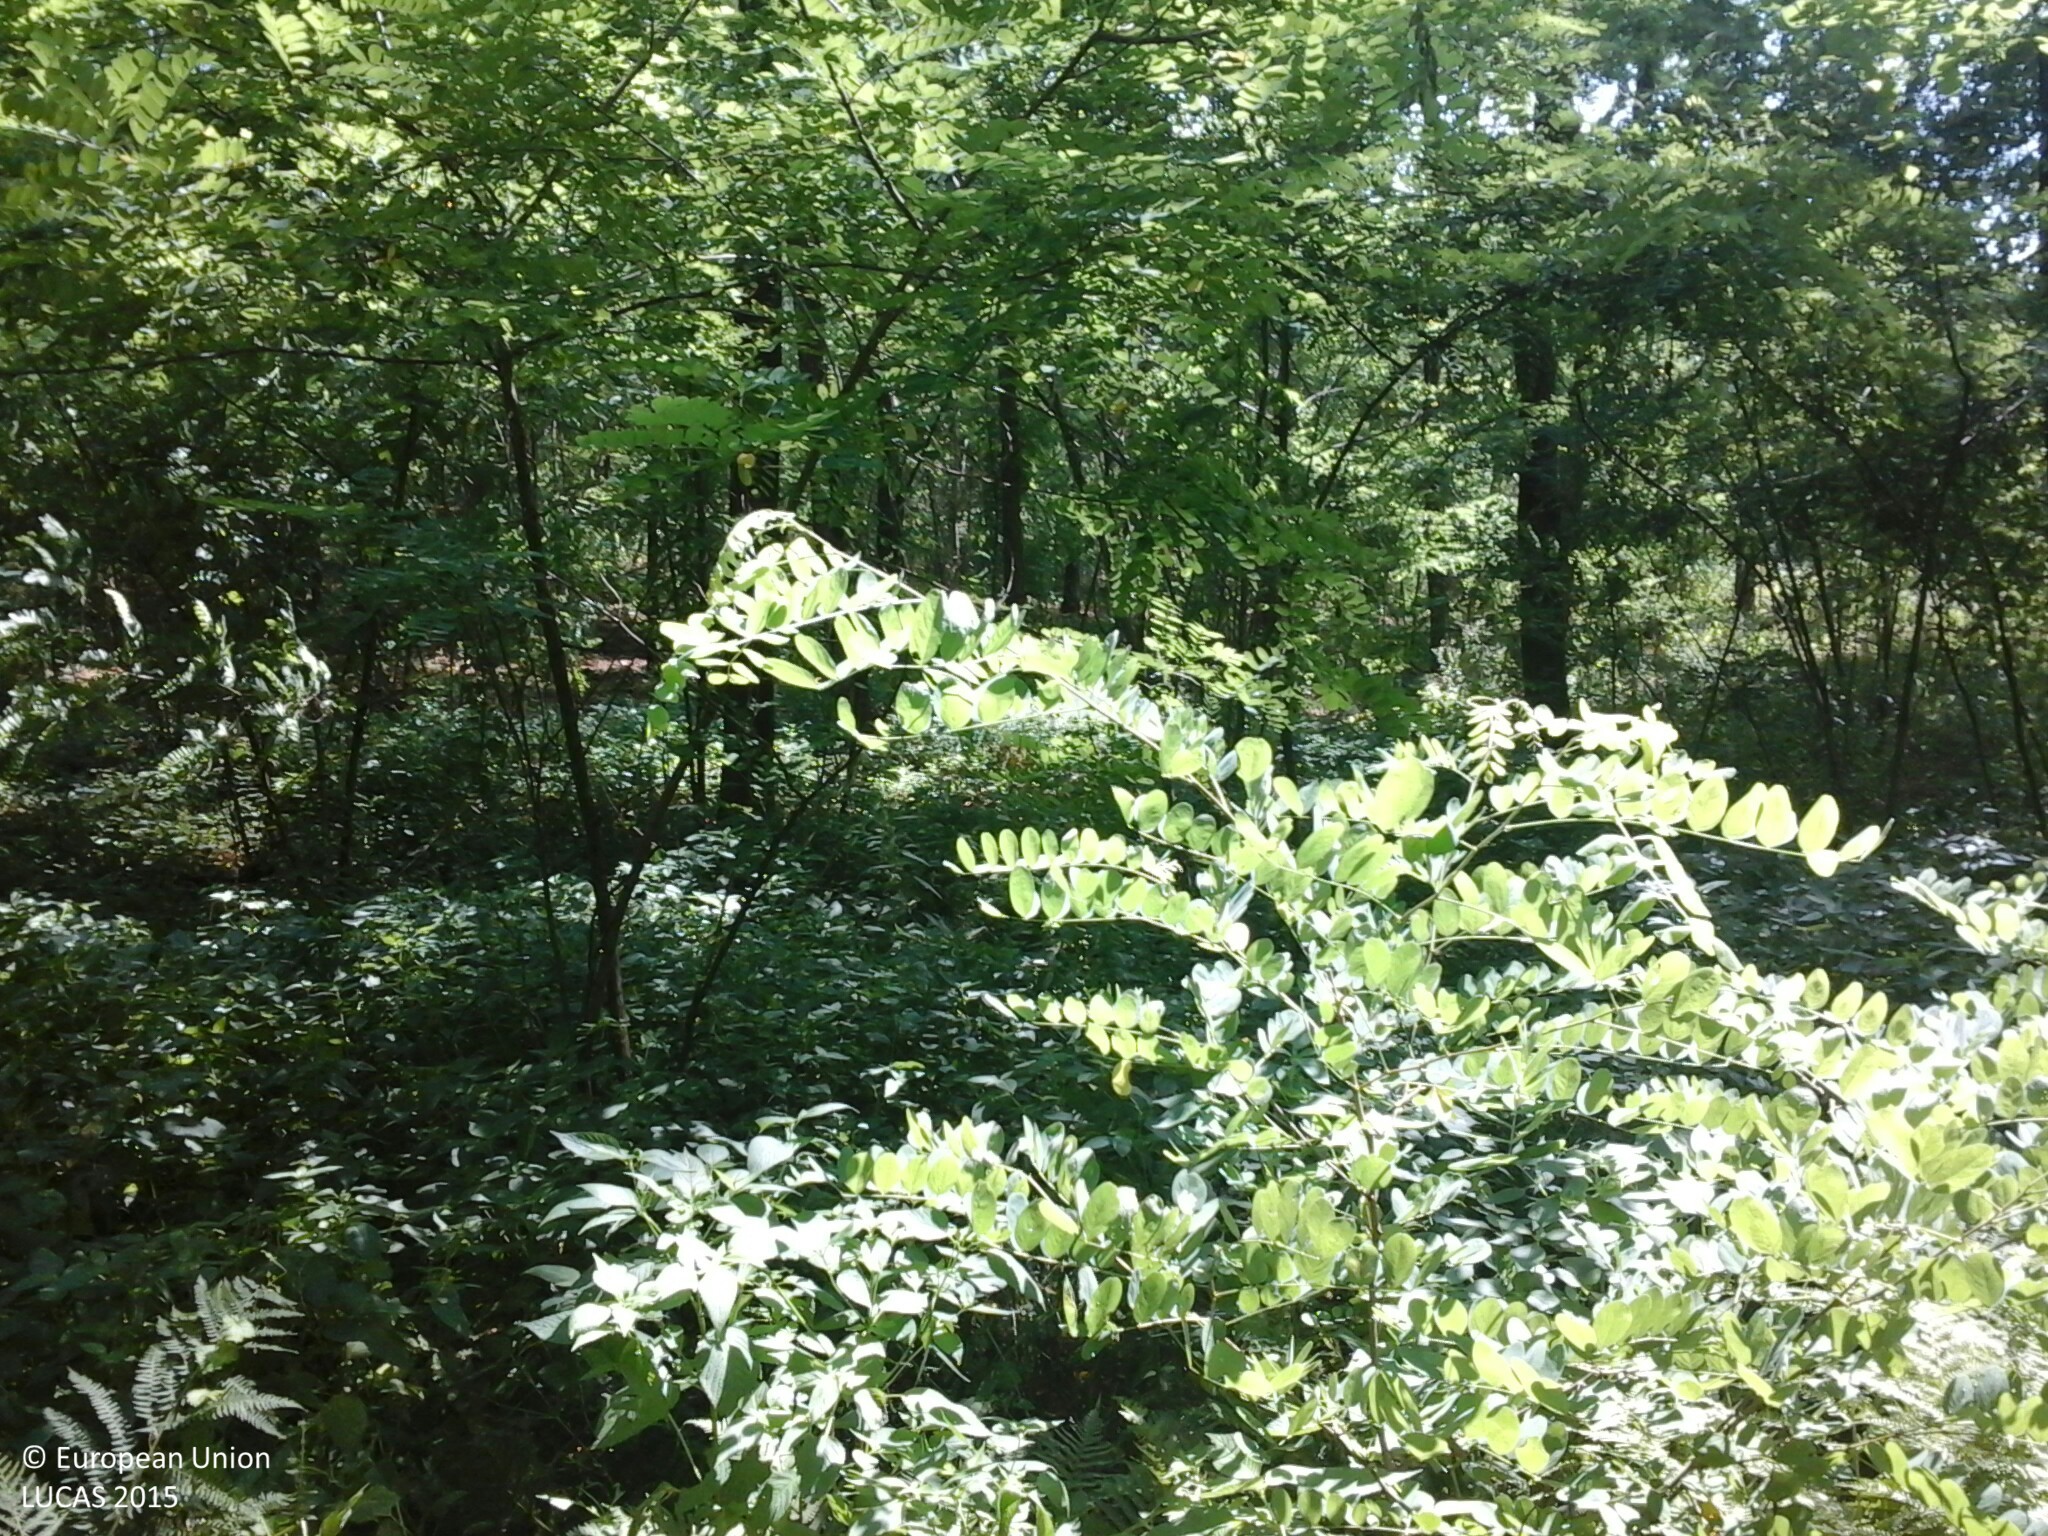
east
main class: Woodland
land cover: Broadleaved woodland
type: mesophytic deciduous forest
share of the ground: > 75 %
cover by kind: broadleaved forest trees 100 %
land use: Forestry
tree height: > 5 m
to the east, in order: Broadleaved woodland; Tracks; Broadleaved woodland
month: July
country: HU
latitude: 48.3068
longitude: 22.2041
